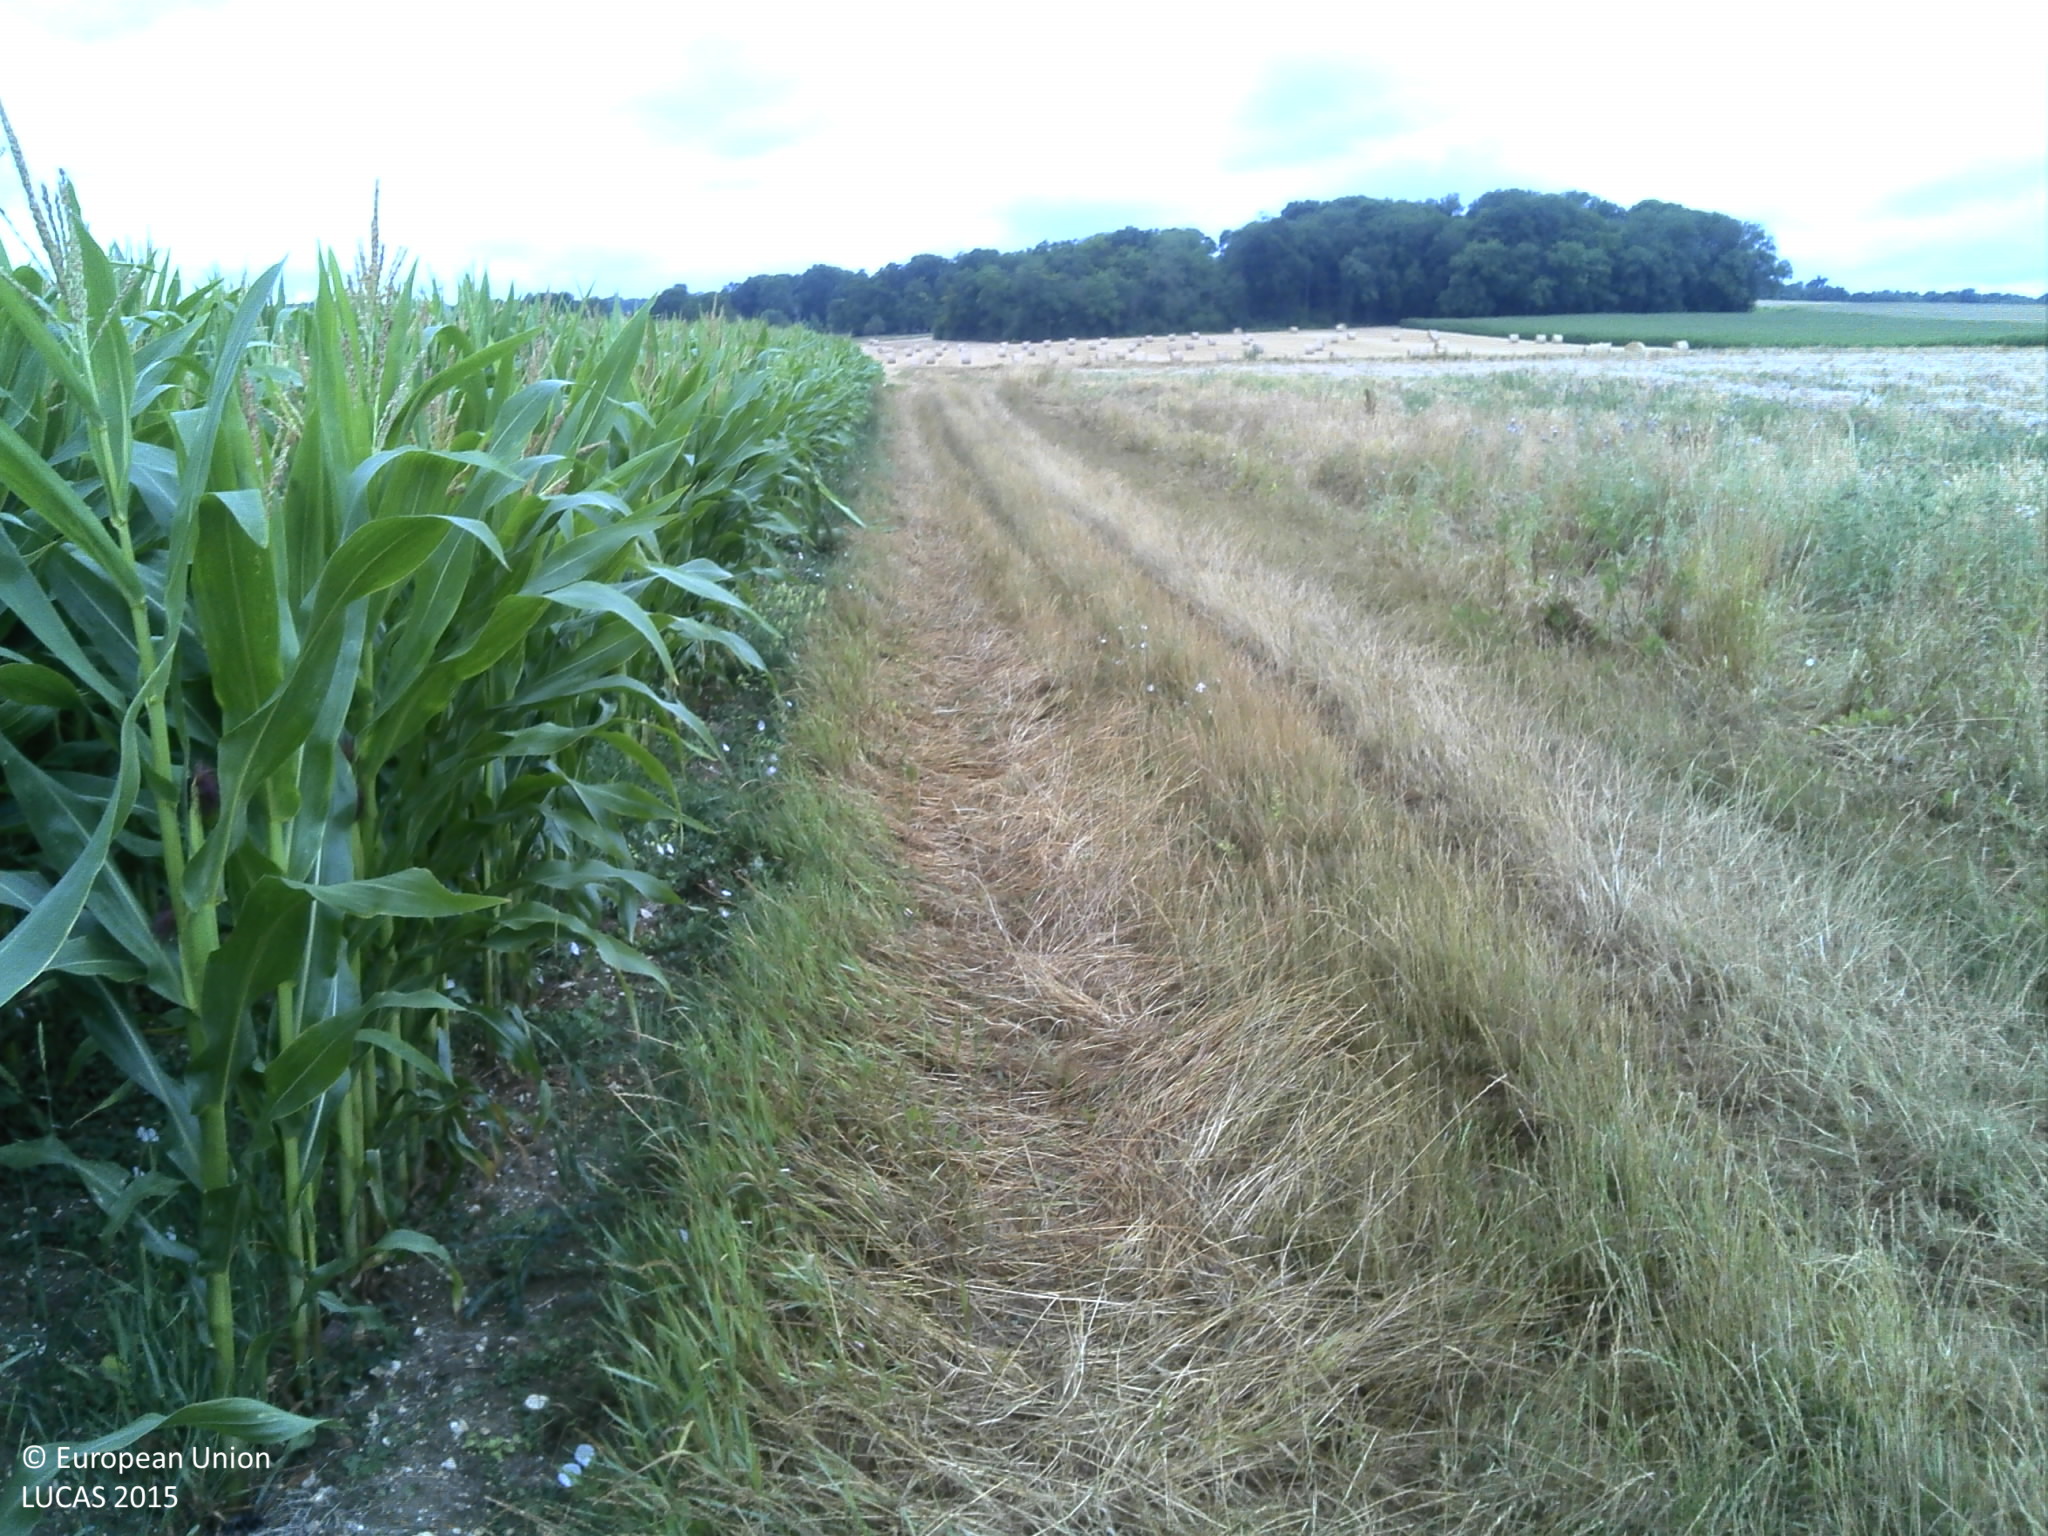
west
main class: Cropland
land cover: Maize
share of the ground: > 75 %
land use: Agriculture (excluding fallow land and kitchen gardens)
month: July
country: FR
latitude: 49.0084
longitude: 1.8778
